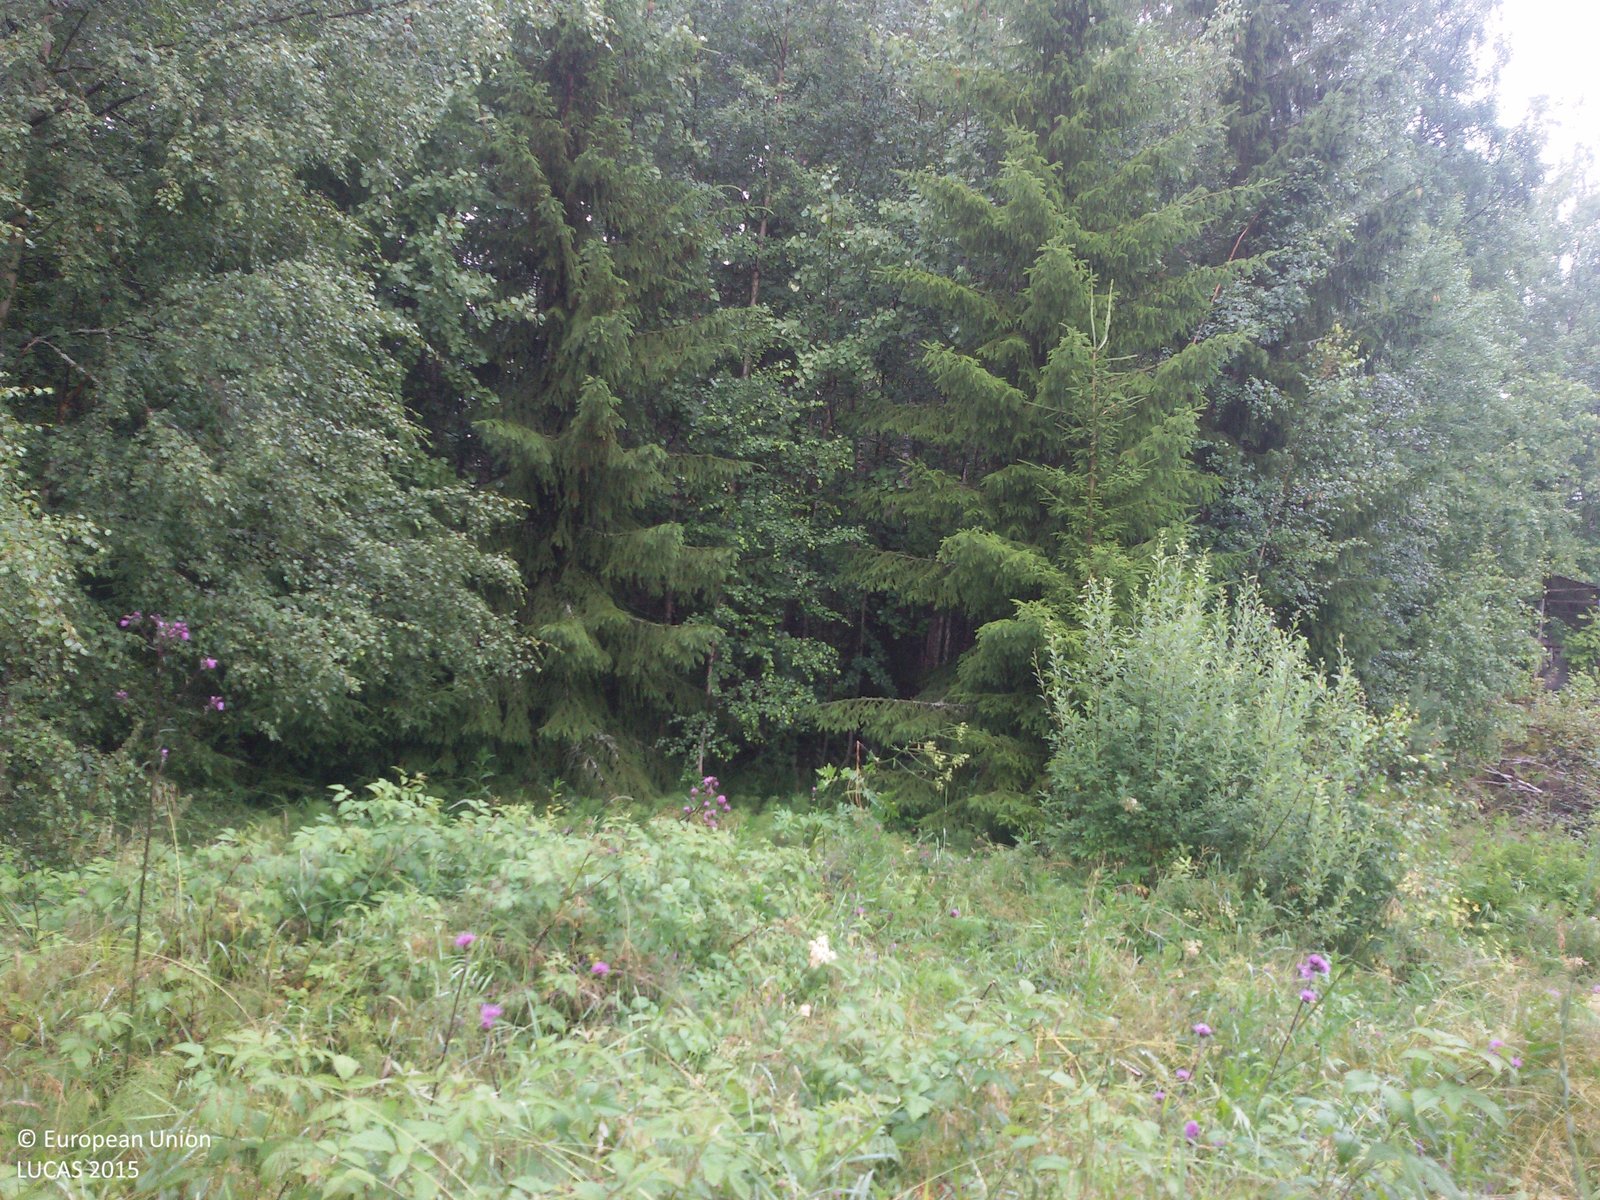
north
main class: Shrubland
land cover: Shrubland with sparse tree cover
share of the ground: > 75 %
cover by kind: shrubs 85 %, herbaceous plants 10 %, coniferous forest trees 5 %
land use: Electricity, gas and thermal power distribution
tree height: < 5 m
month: July
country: SE
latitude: 60.5488
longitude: 15.8039
